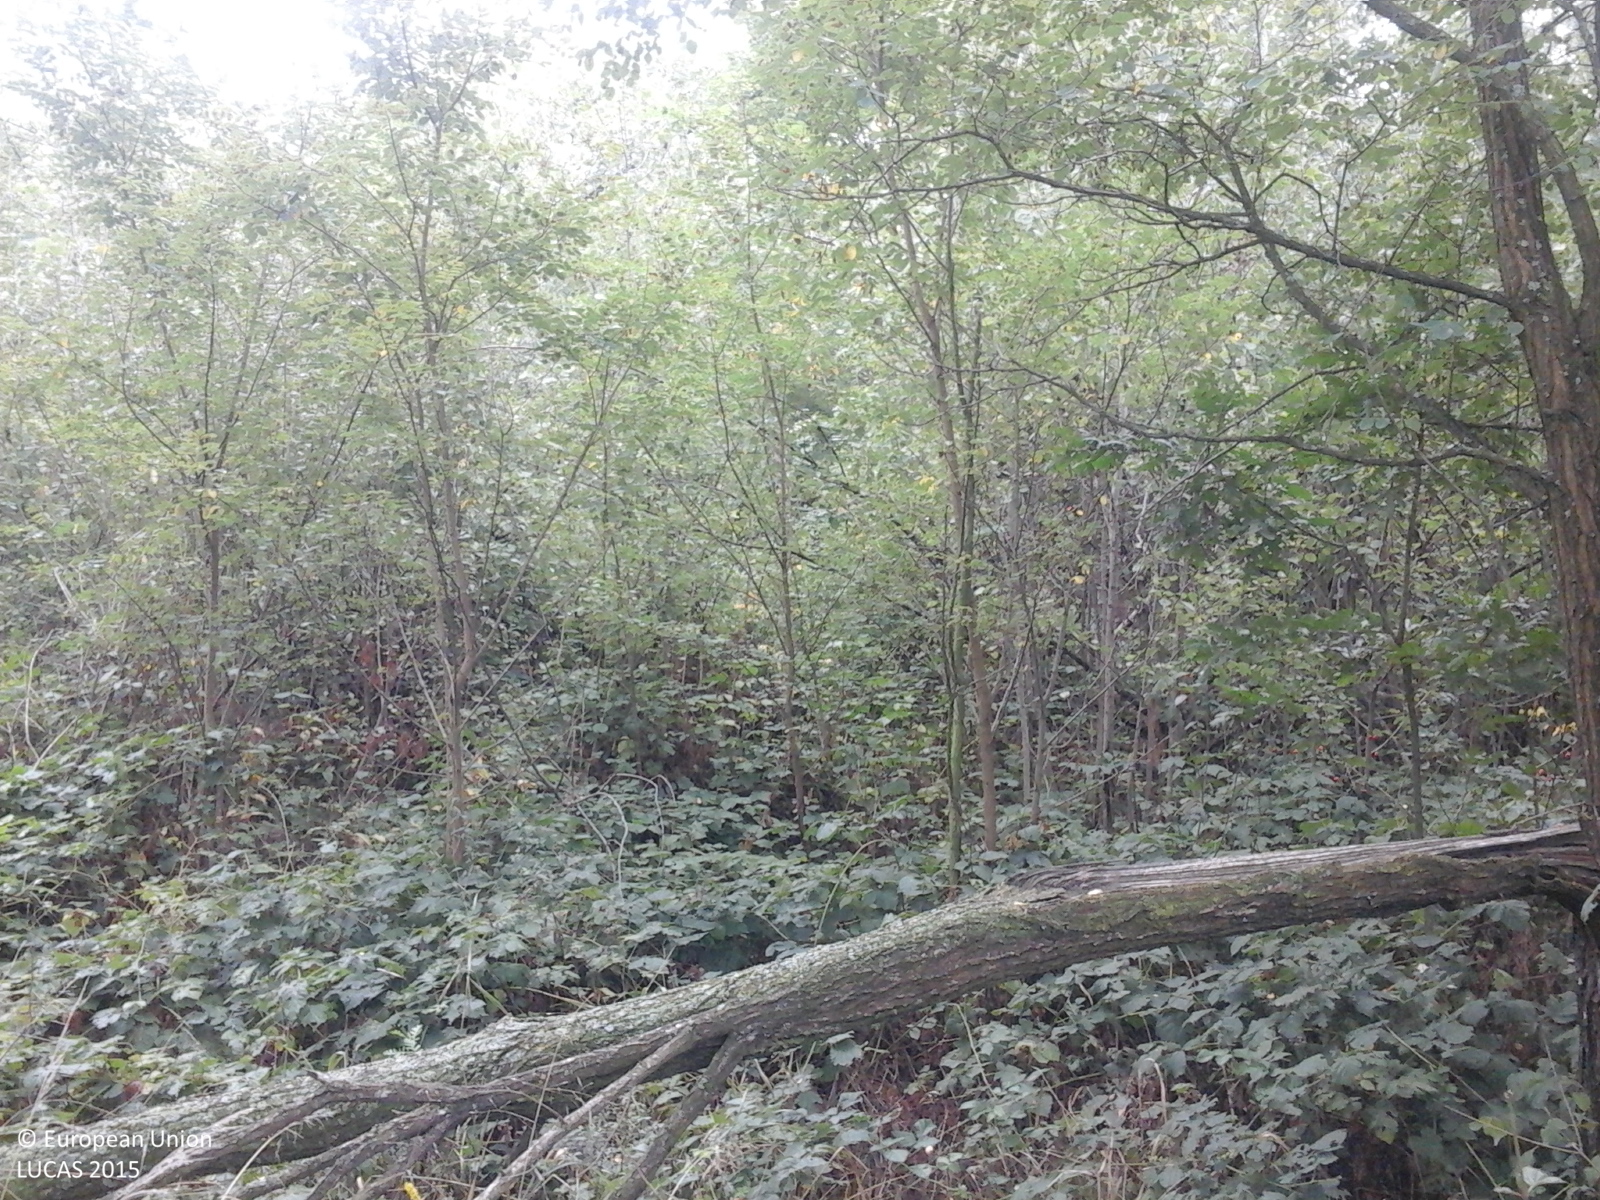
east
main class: Woodland
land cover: Broadleaved woodland
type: exotic forest
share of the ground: > 75 %
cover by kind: broadleaved forest trees 75 %, herbaceous plants 25 %
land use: Forestry
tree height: > 5 m
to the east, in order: Broadleaved woodland; Tracks; Shrubland with sparse tree cover
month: September
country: RO
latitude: 45.5055
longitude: 22.0315
